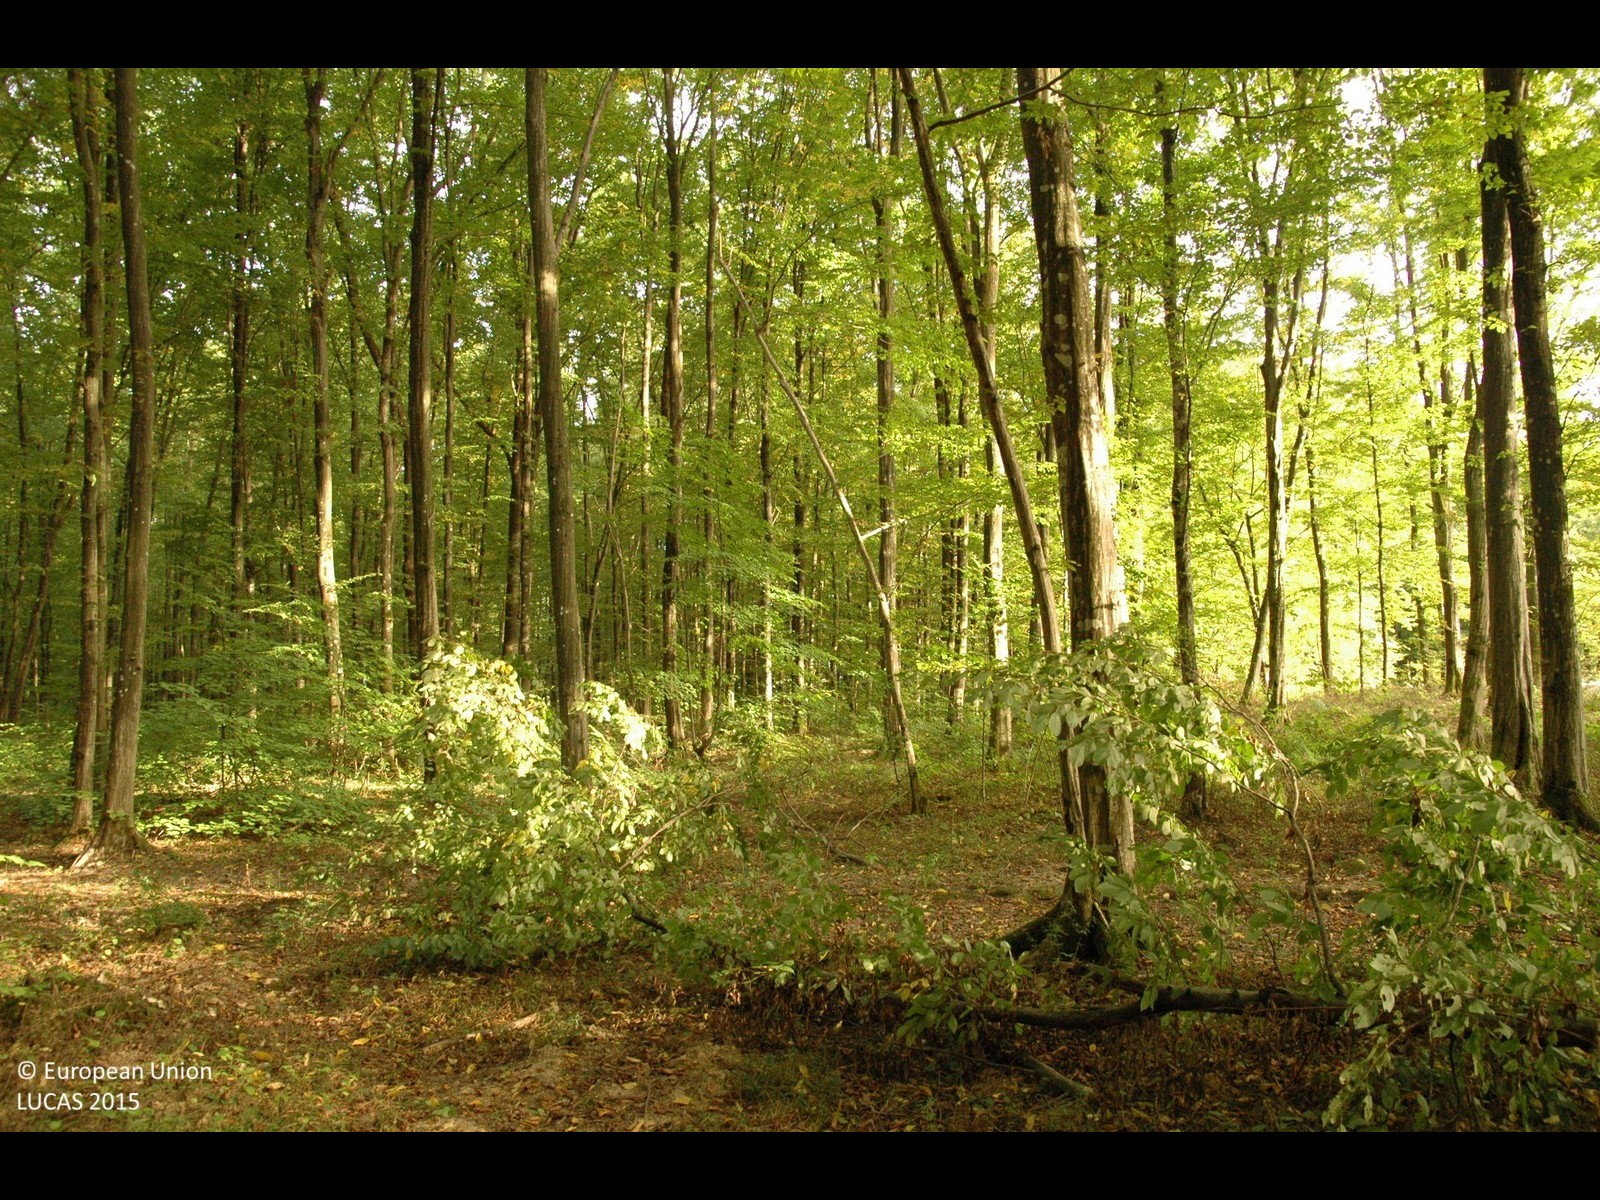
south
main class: Woodland
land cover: Broadleaved woodland
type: mesophytic deciduous forest
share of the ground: > 75 %
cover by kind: broadleaved forest trees 100 %
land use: Forestry
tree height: > 5 m
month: September
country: HR
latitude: 45.7040
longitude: 15.8414
